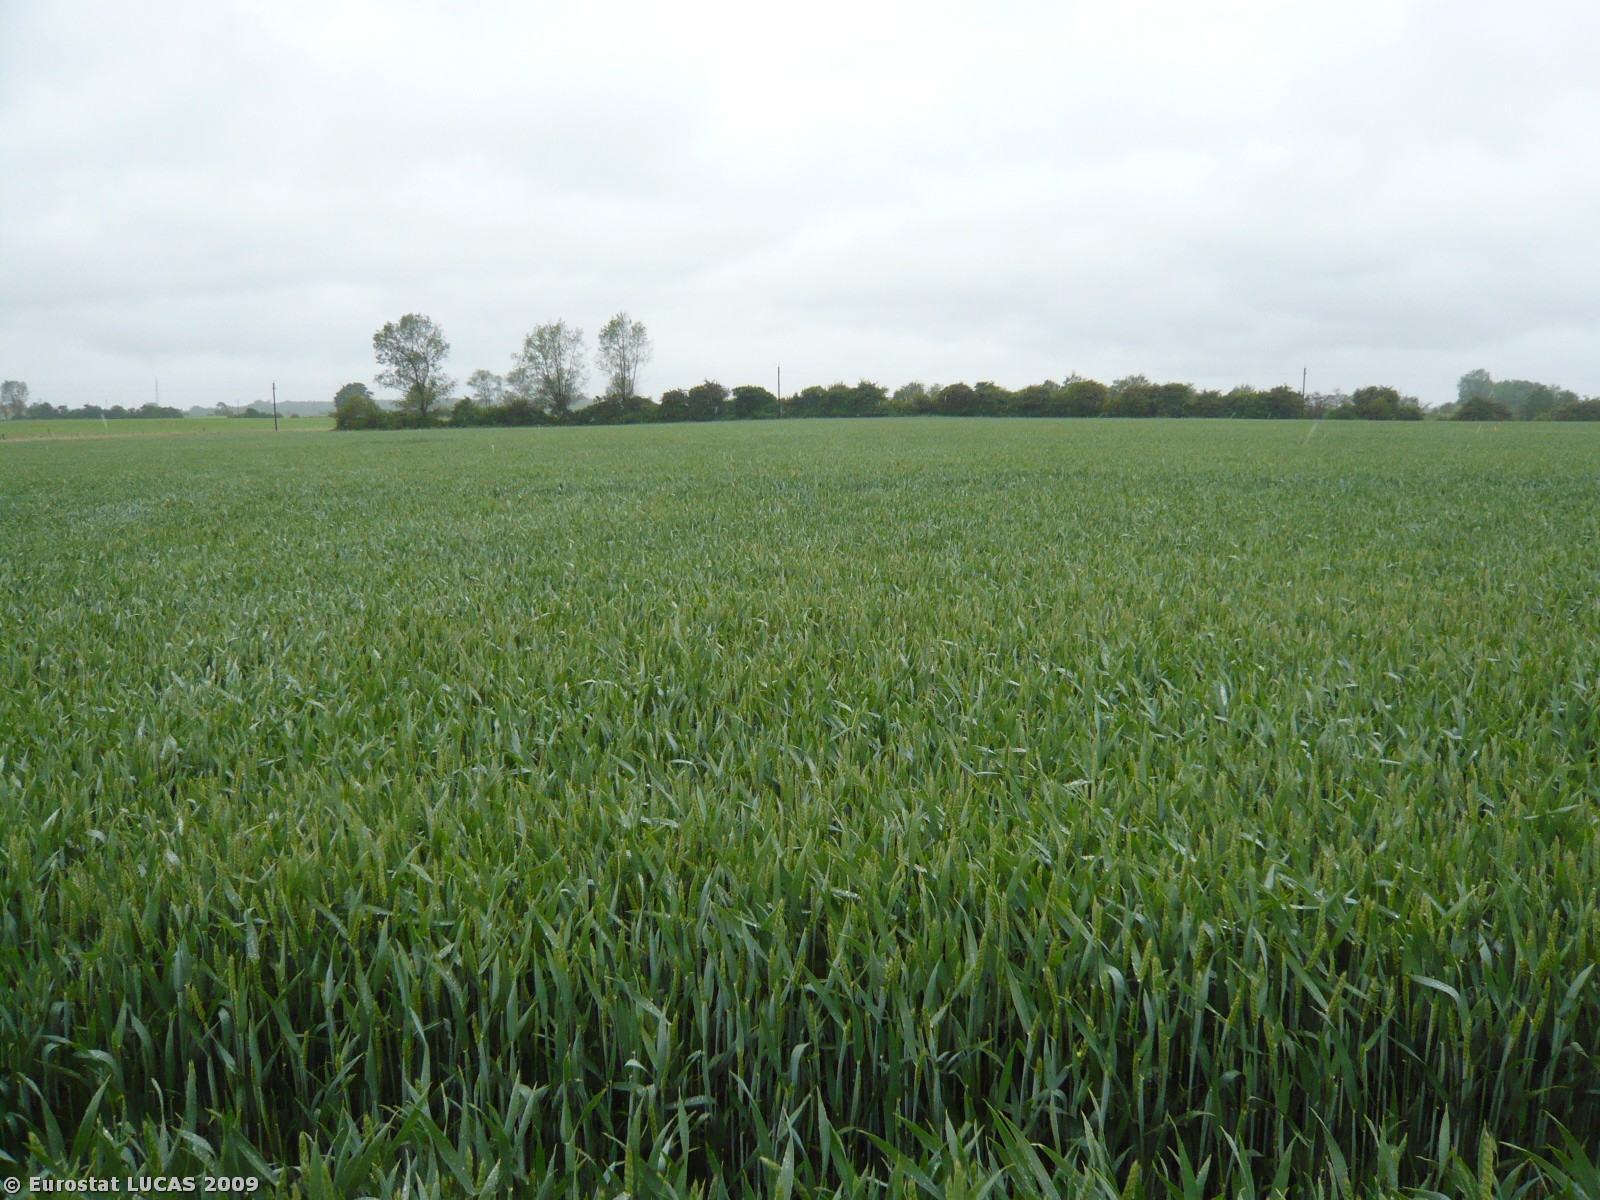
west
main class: Cropland
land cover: Common wheat
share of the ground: > 75 %
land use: Agriculture (excluding fallow land and kitchen gardens)
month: June
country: DK
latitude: 54.7707
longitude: 11.9418
